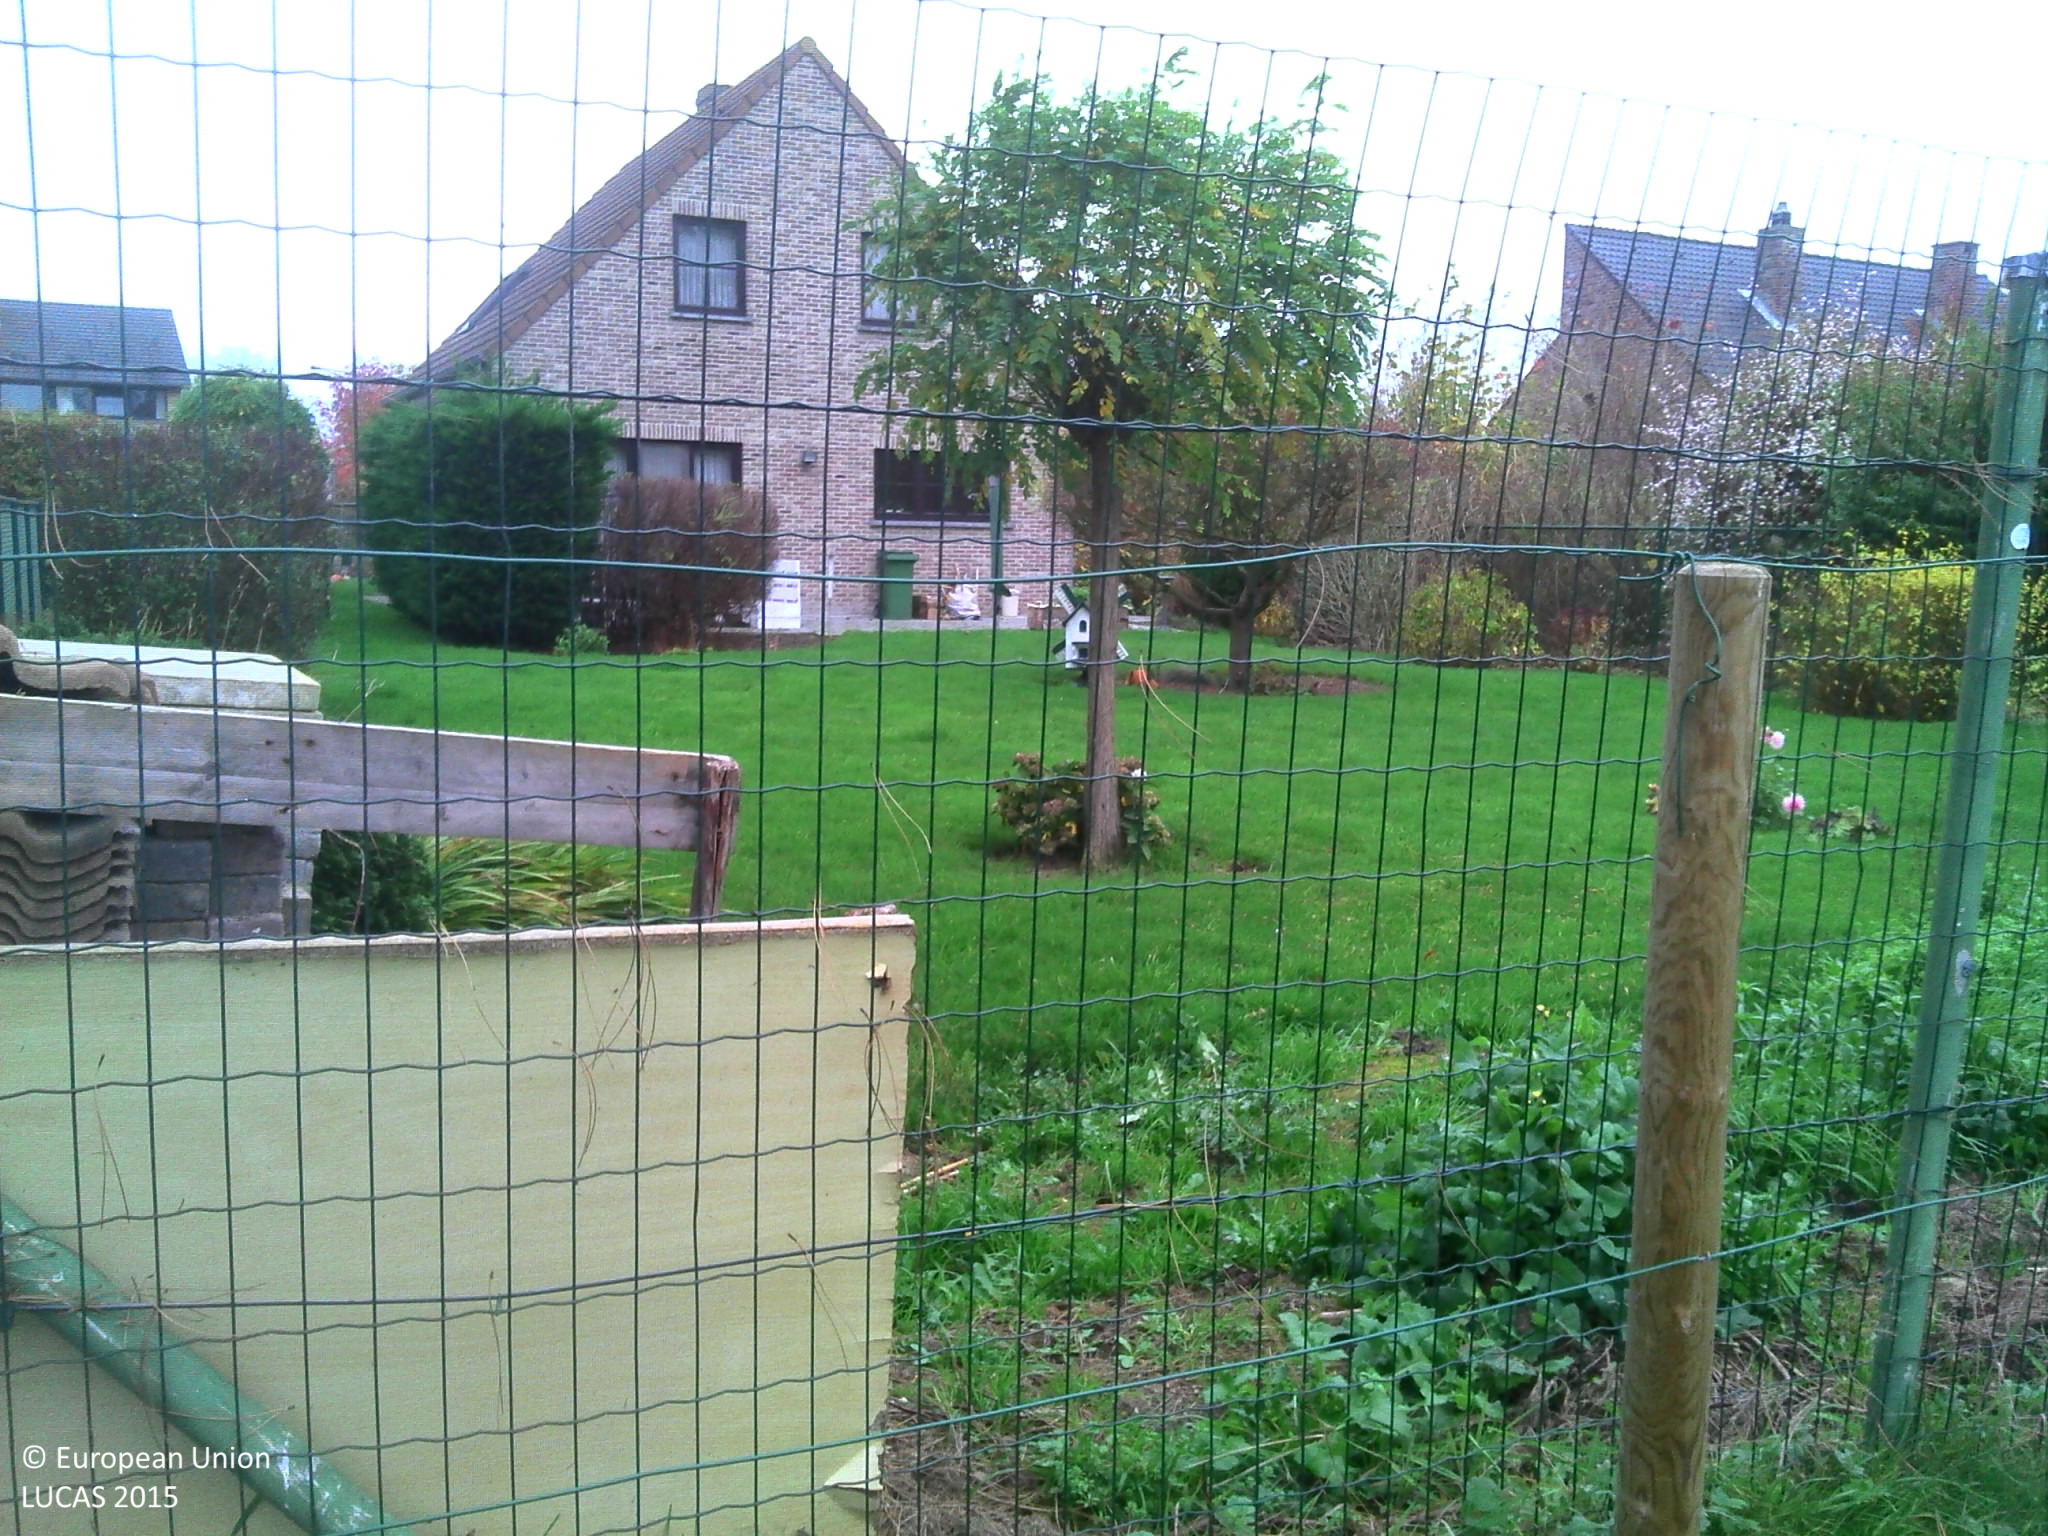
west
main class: Grassland
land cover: Grassland with sparse tree/shrub cover
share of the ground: > 75 %
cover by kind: herbaceous plants 85 %, shrubs 10 %, broadleaved forest trees 5 %
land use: Residential
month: November
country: BE
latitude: 50.9229
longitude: 4.6329
